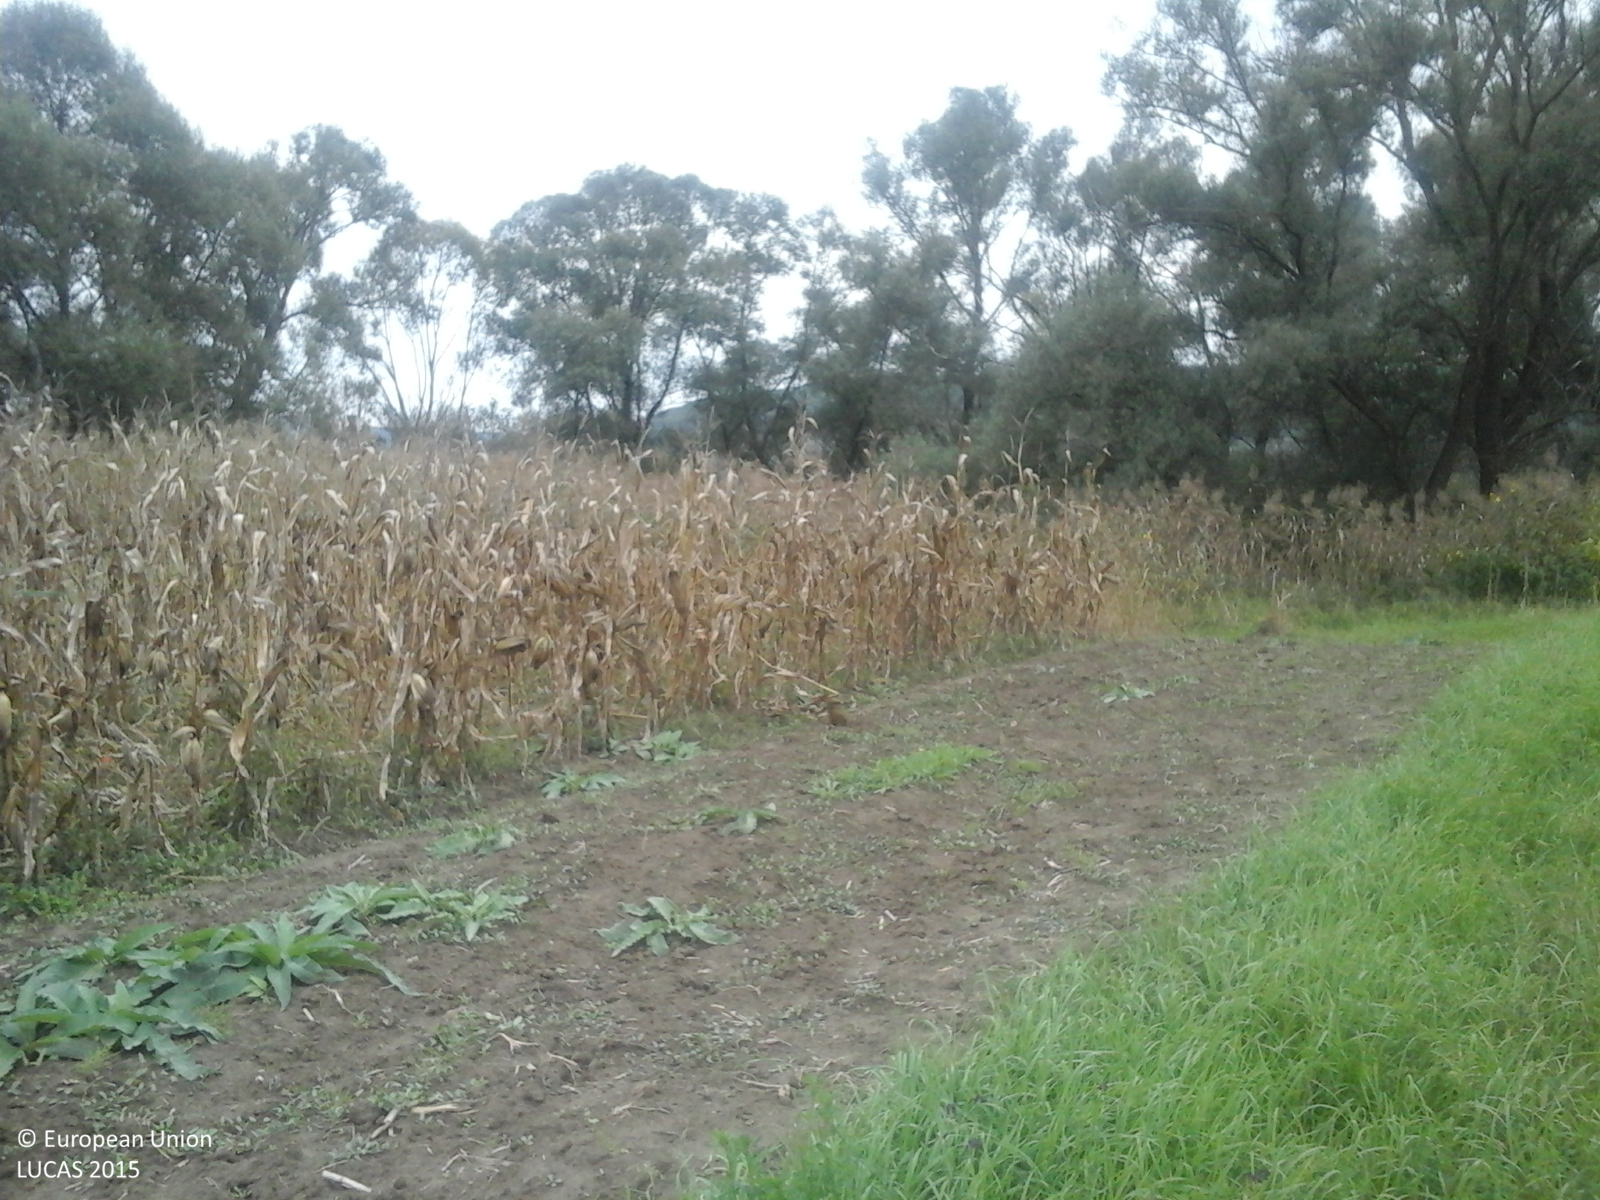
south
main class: Cropland
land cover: Lucerne
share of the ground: > 75 %
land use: Agriculture (excluding fallow land and kitchen gardens)
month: October
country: RO
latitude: 46.4152
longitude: 24.7804
